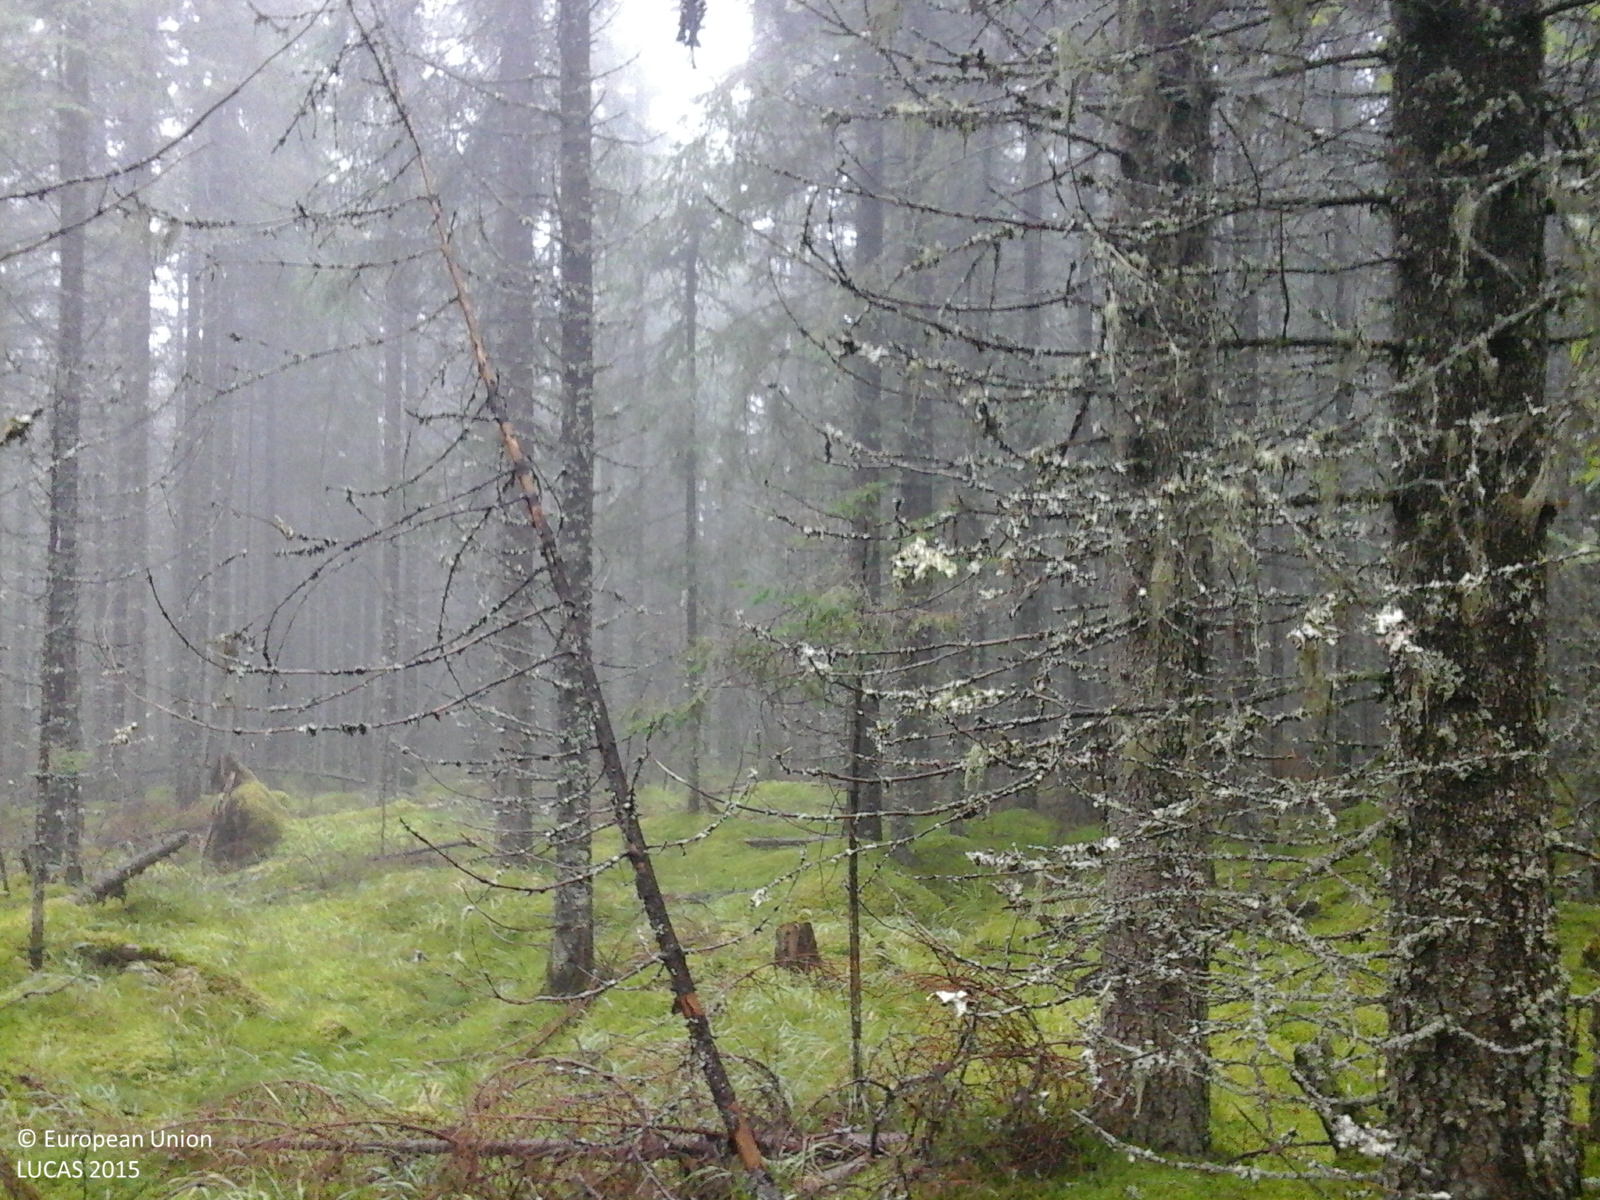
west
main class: Woodland
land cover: Spruce dominated coniferous woodland
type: alpine coniferous forest
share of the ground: > 75 %
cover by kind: coniferous forest trees 90 %, herbaceous plants 10 %
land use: Forestry
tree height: > 5 m
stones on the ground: > 50 %
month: September
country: RO
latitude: 45.6433
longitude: 23.7303
